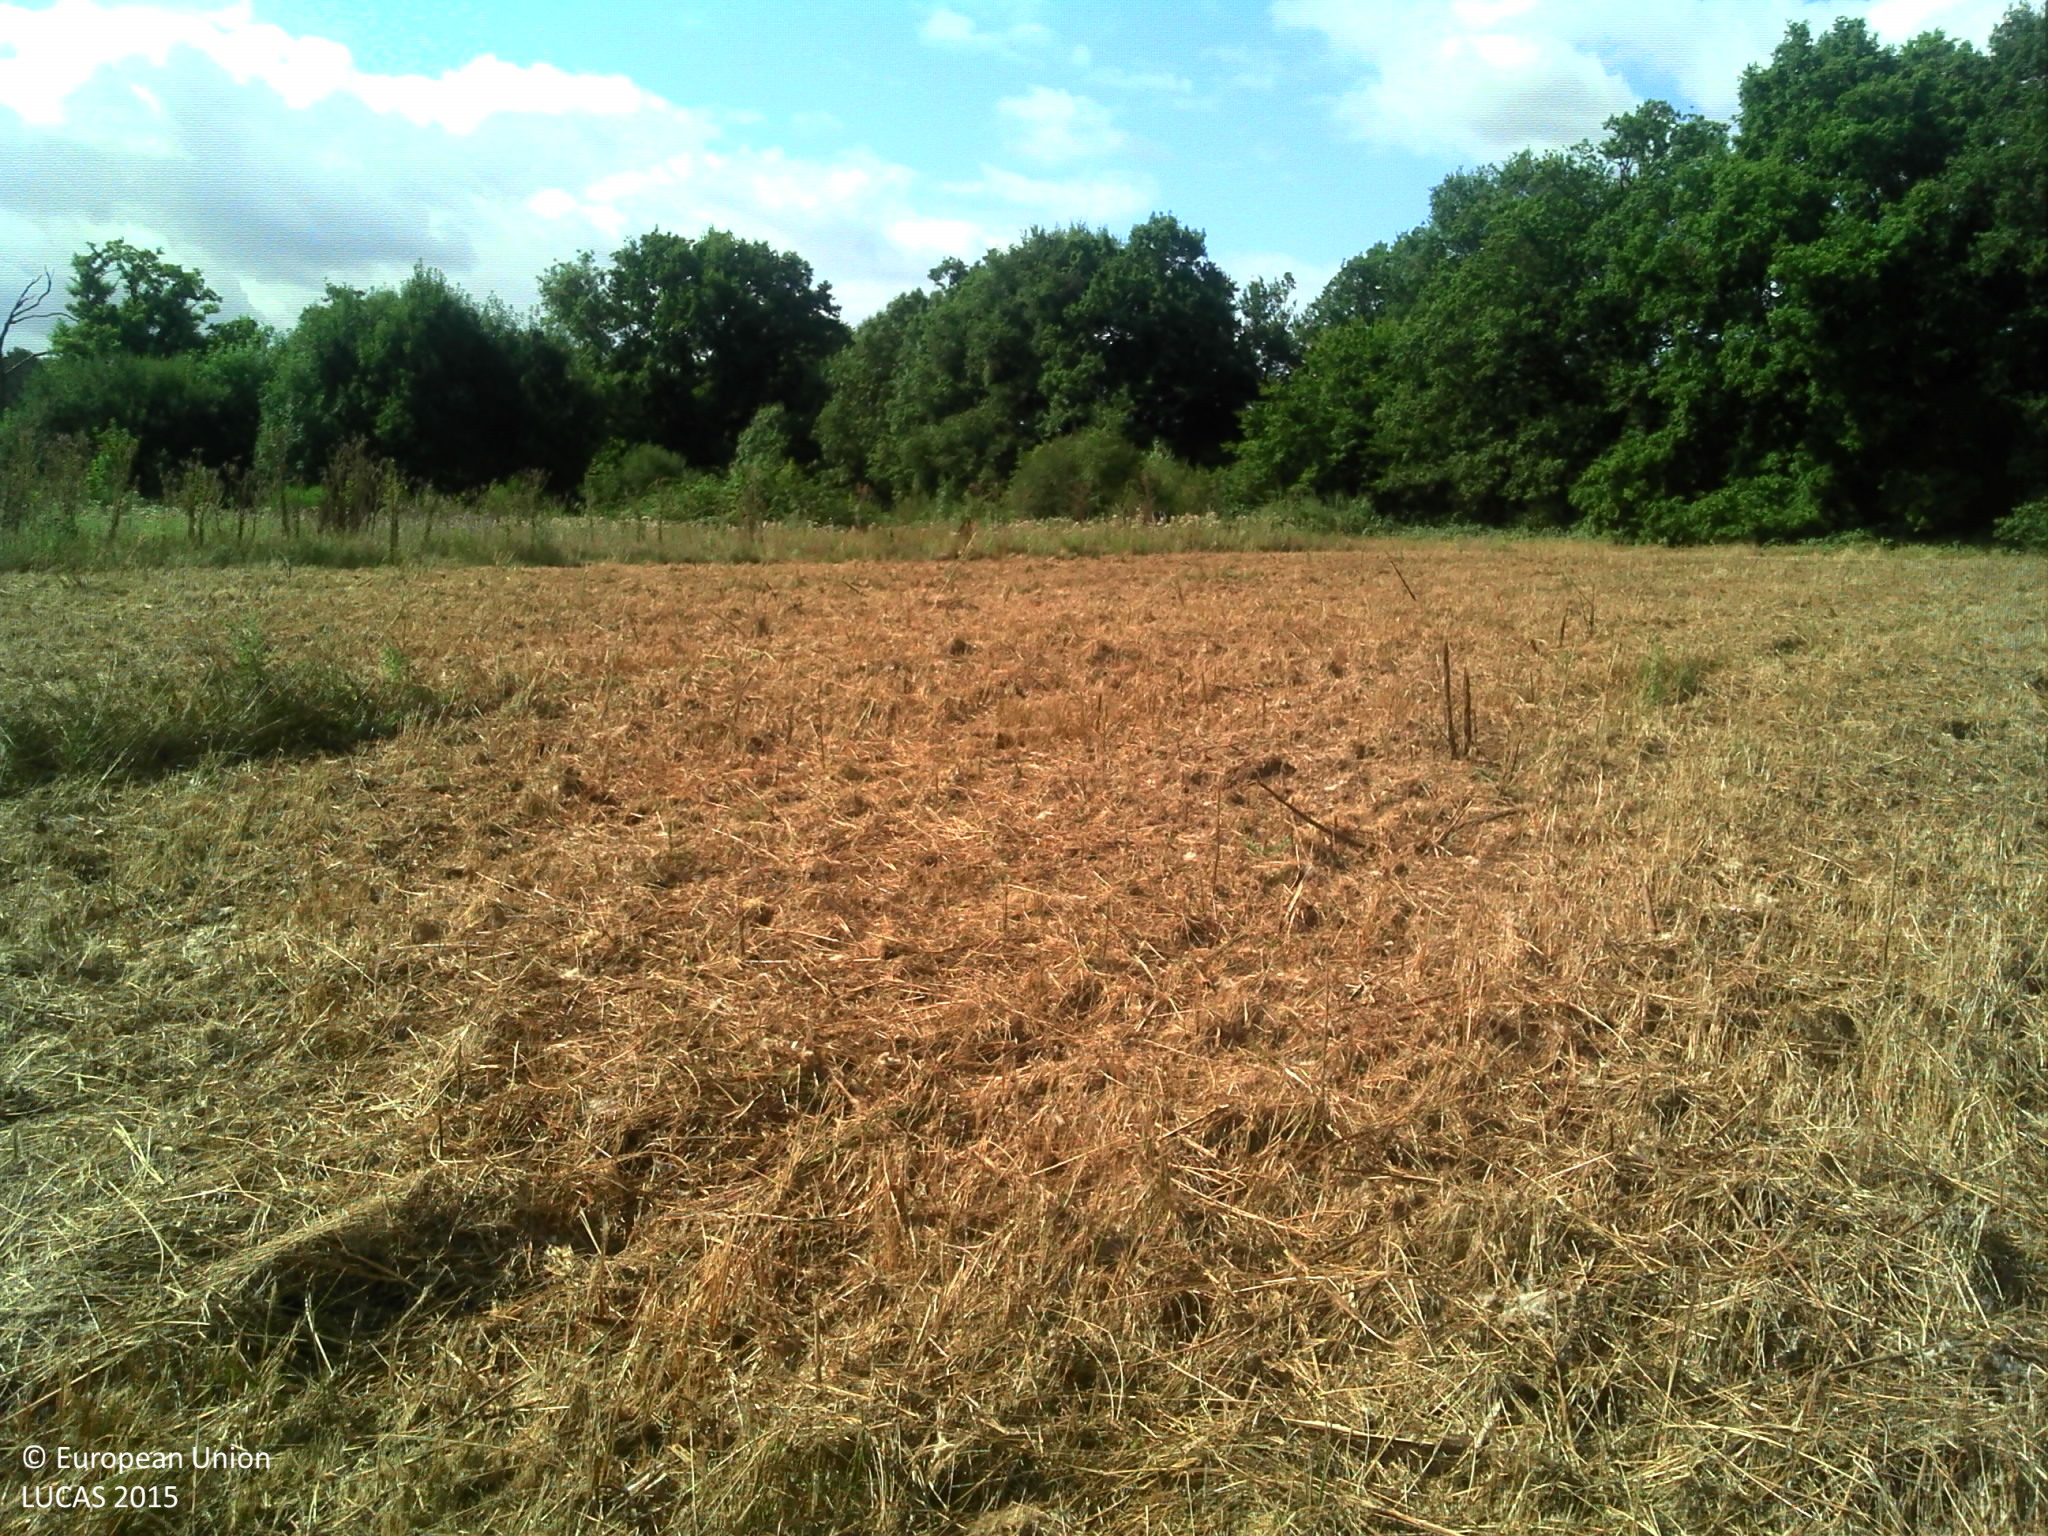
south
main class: Grassland
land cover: Grassland without tree/shrub cover
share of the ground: > 75 %
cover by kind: herbaceous plants 100 %
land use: Agriculture (excluding fallow land and kitchen gardens)
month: July
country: FR
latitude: 46.2780
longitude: 1.2028
